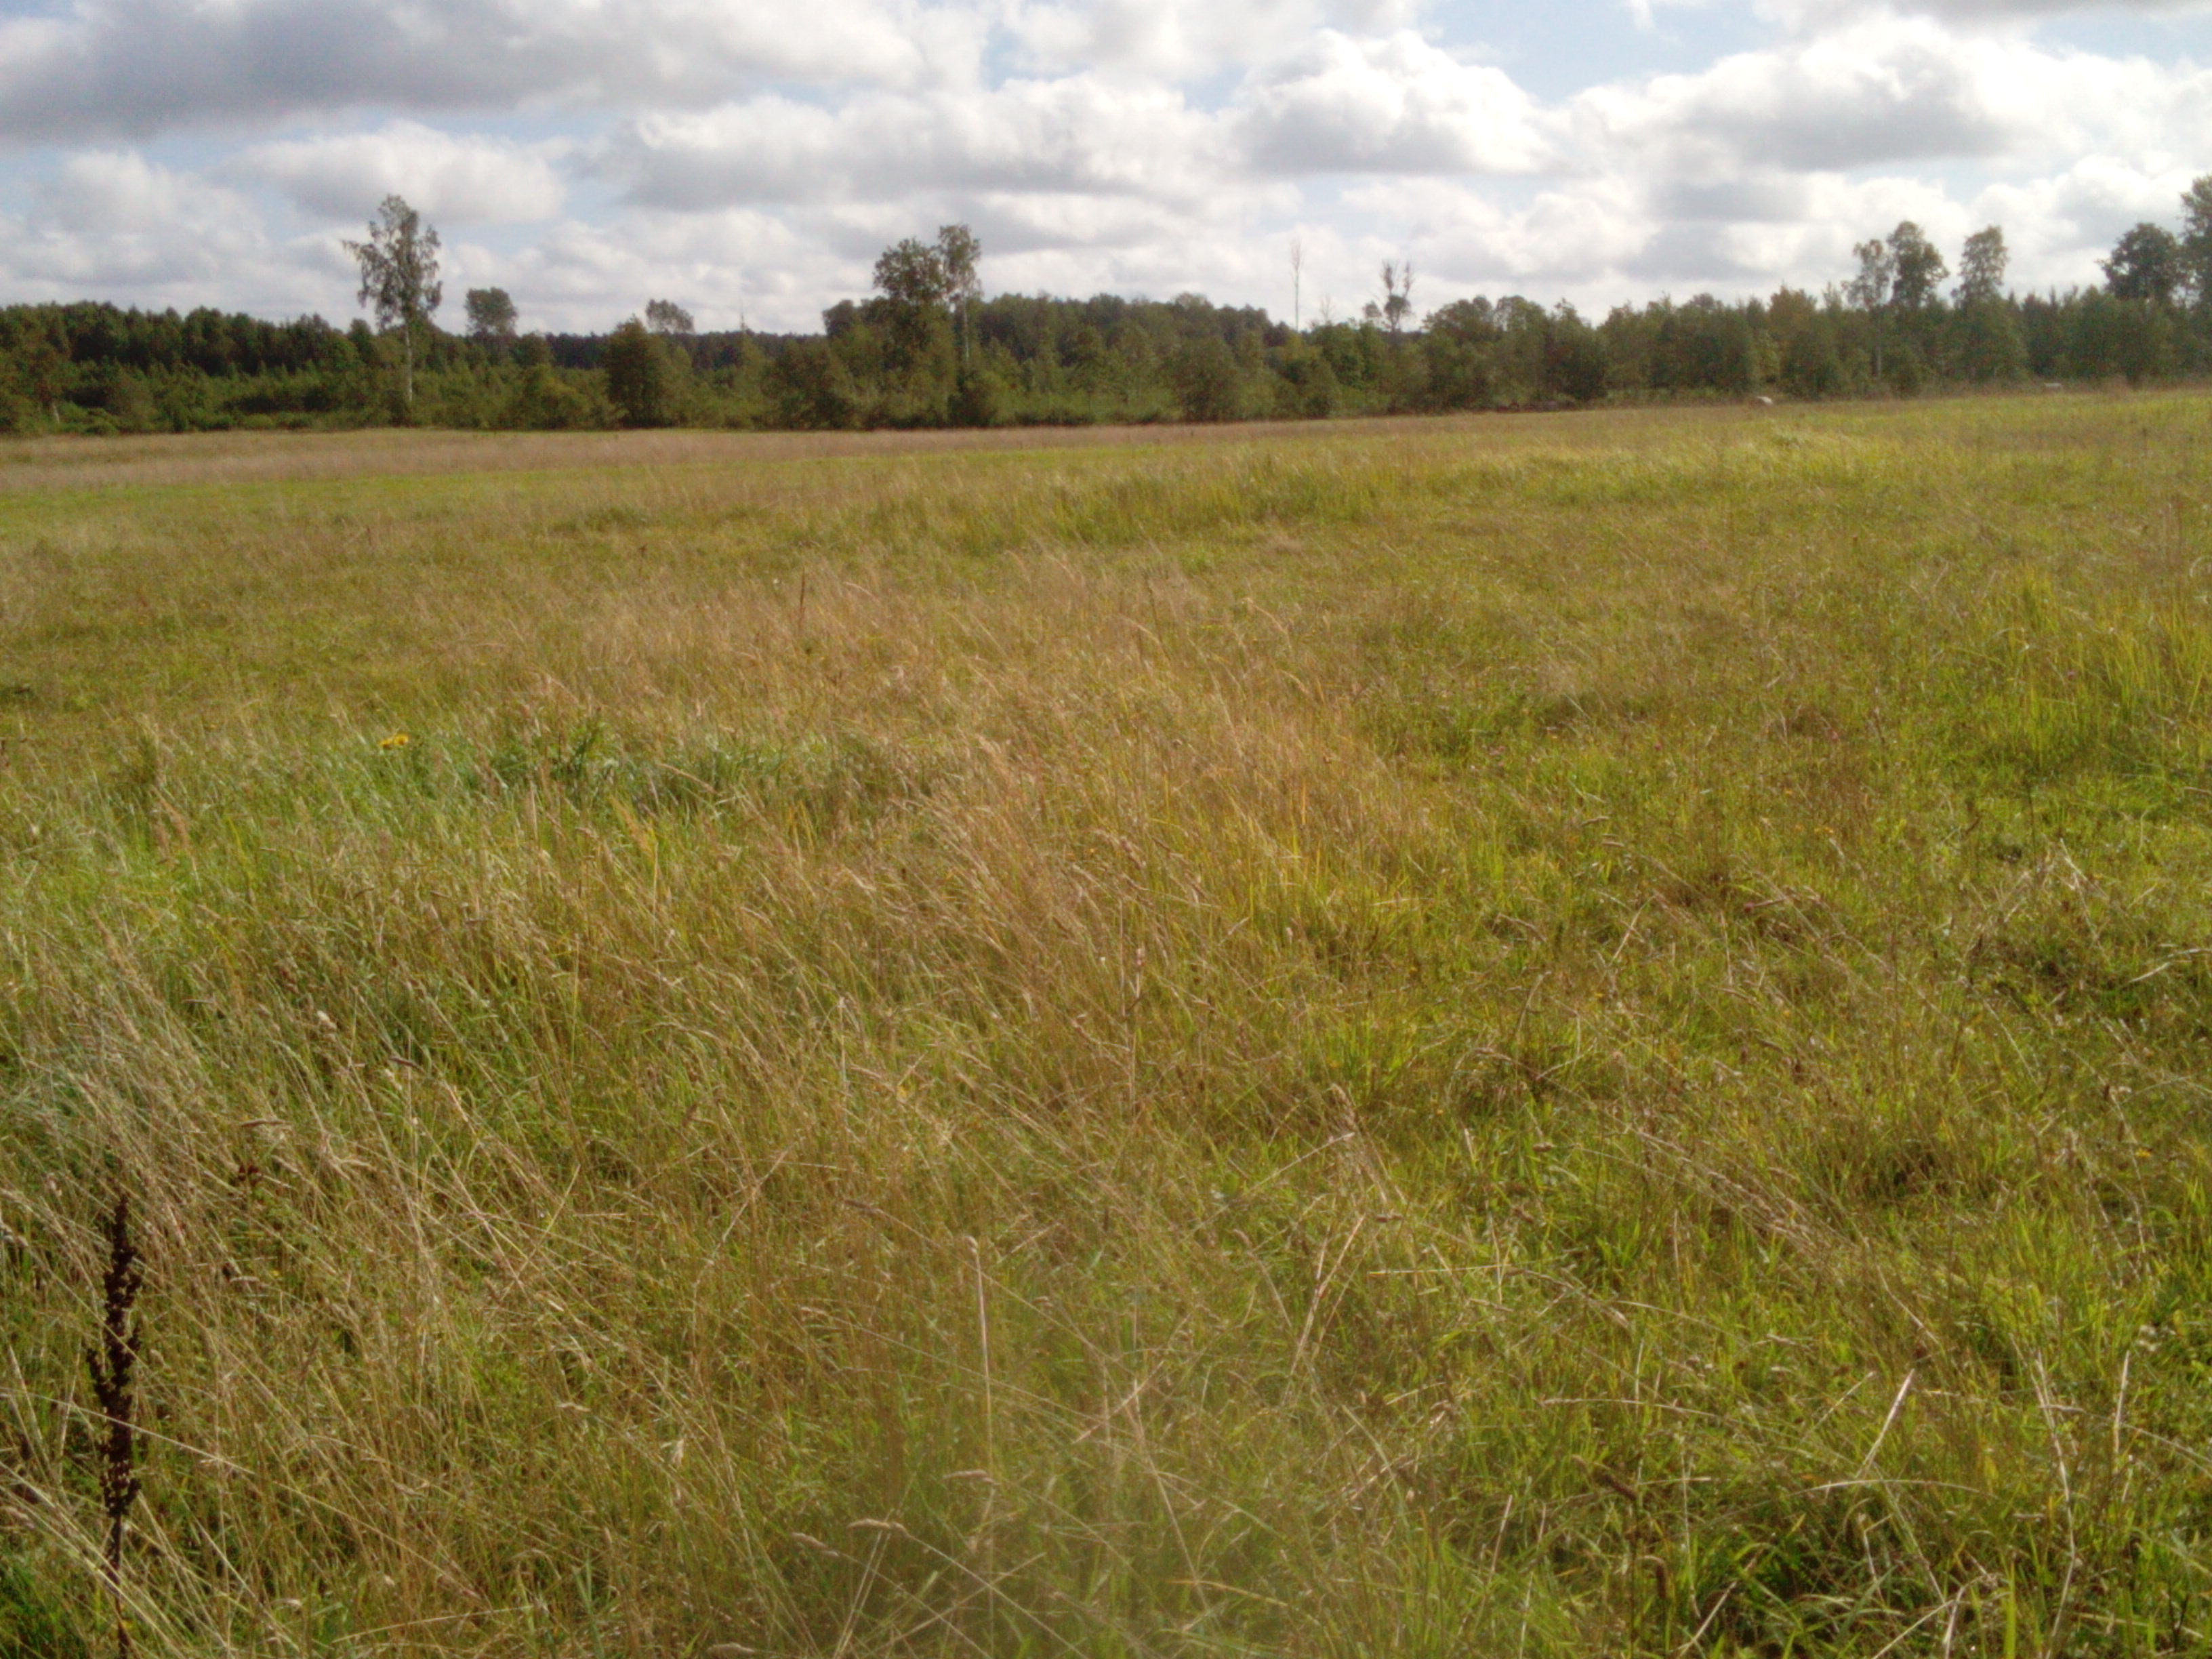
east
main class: Grassland
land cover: Grassland without tree/shrub cover
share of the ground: > 75 %
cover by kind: herbaceous plants 100 %
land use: Agriculture (excluding fallow land and kitchen gardens)
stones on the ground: < 10 %
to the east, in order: Grassland without tree/shrub cover; Fences; Grassland without tree/shrub cover; Fences; Grassland without tree/shrub cover
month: September
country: LT
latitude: 55.9242
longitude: 22.8196
